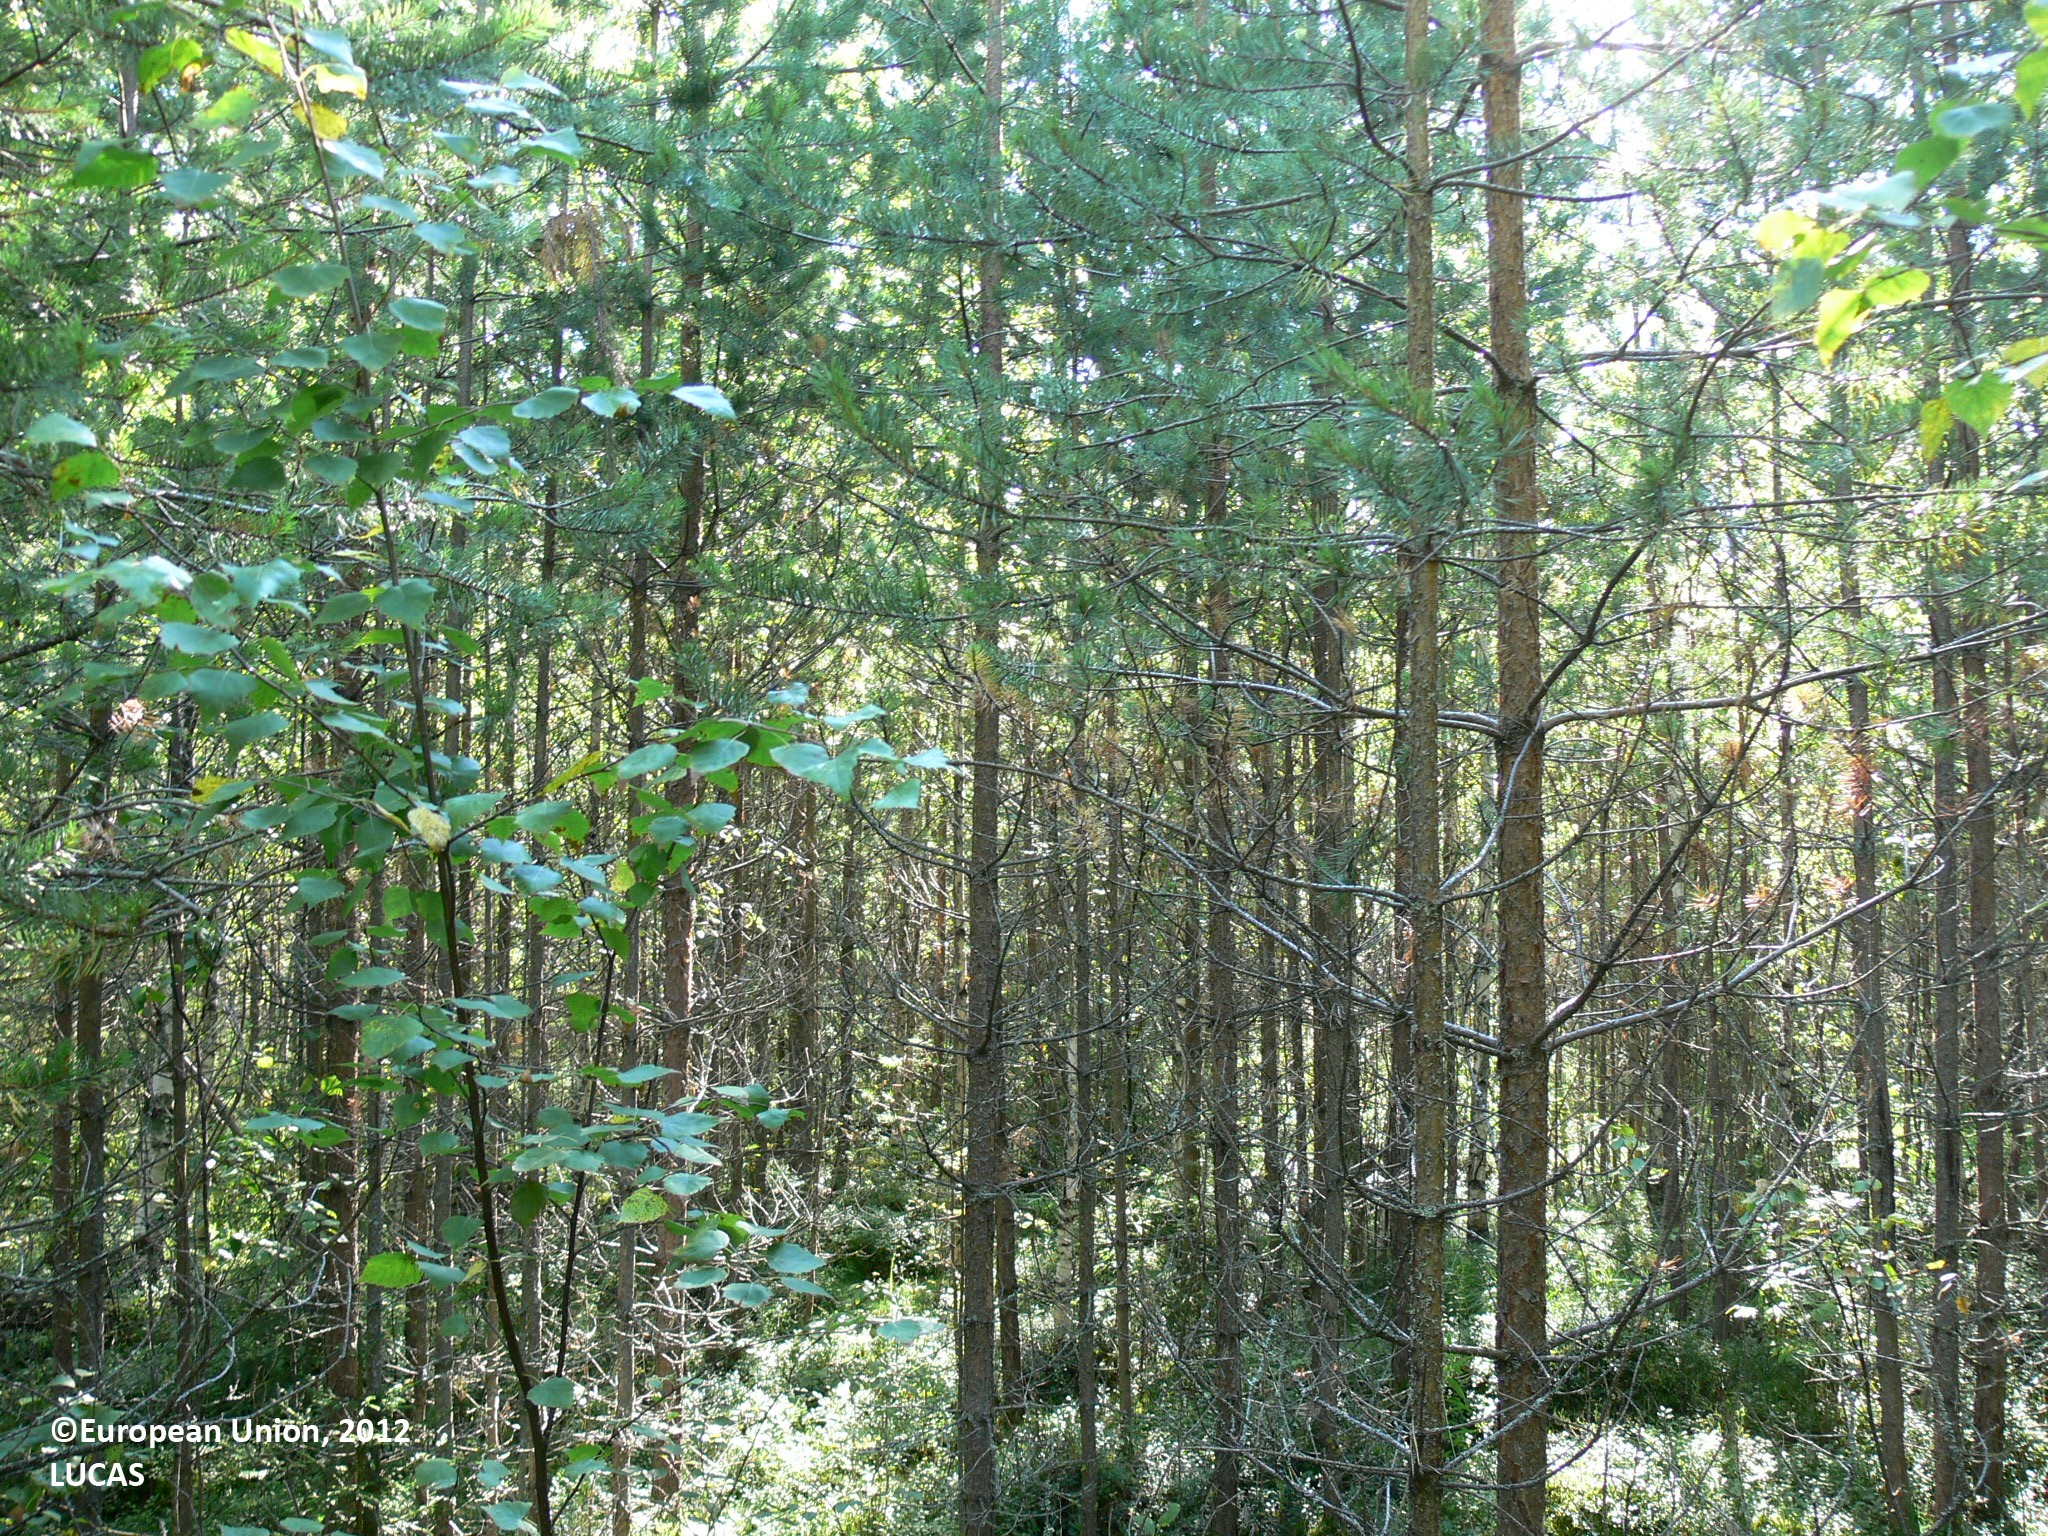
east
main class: Woodland
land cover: Pine dominated mixed woodland
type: boreal forest
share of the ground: 50 - 75 %
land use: Forestry
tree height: > 5 m
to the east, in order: Pine dominated mixed woodland; Pine dominated coniferous woodland; Other mixed woodland
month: August
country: FI
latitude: 63.1560
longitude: 29.5885
